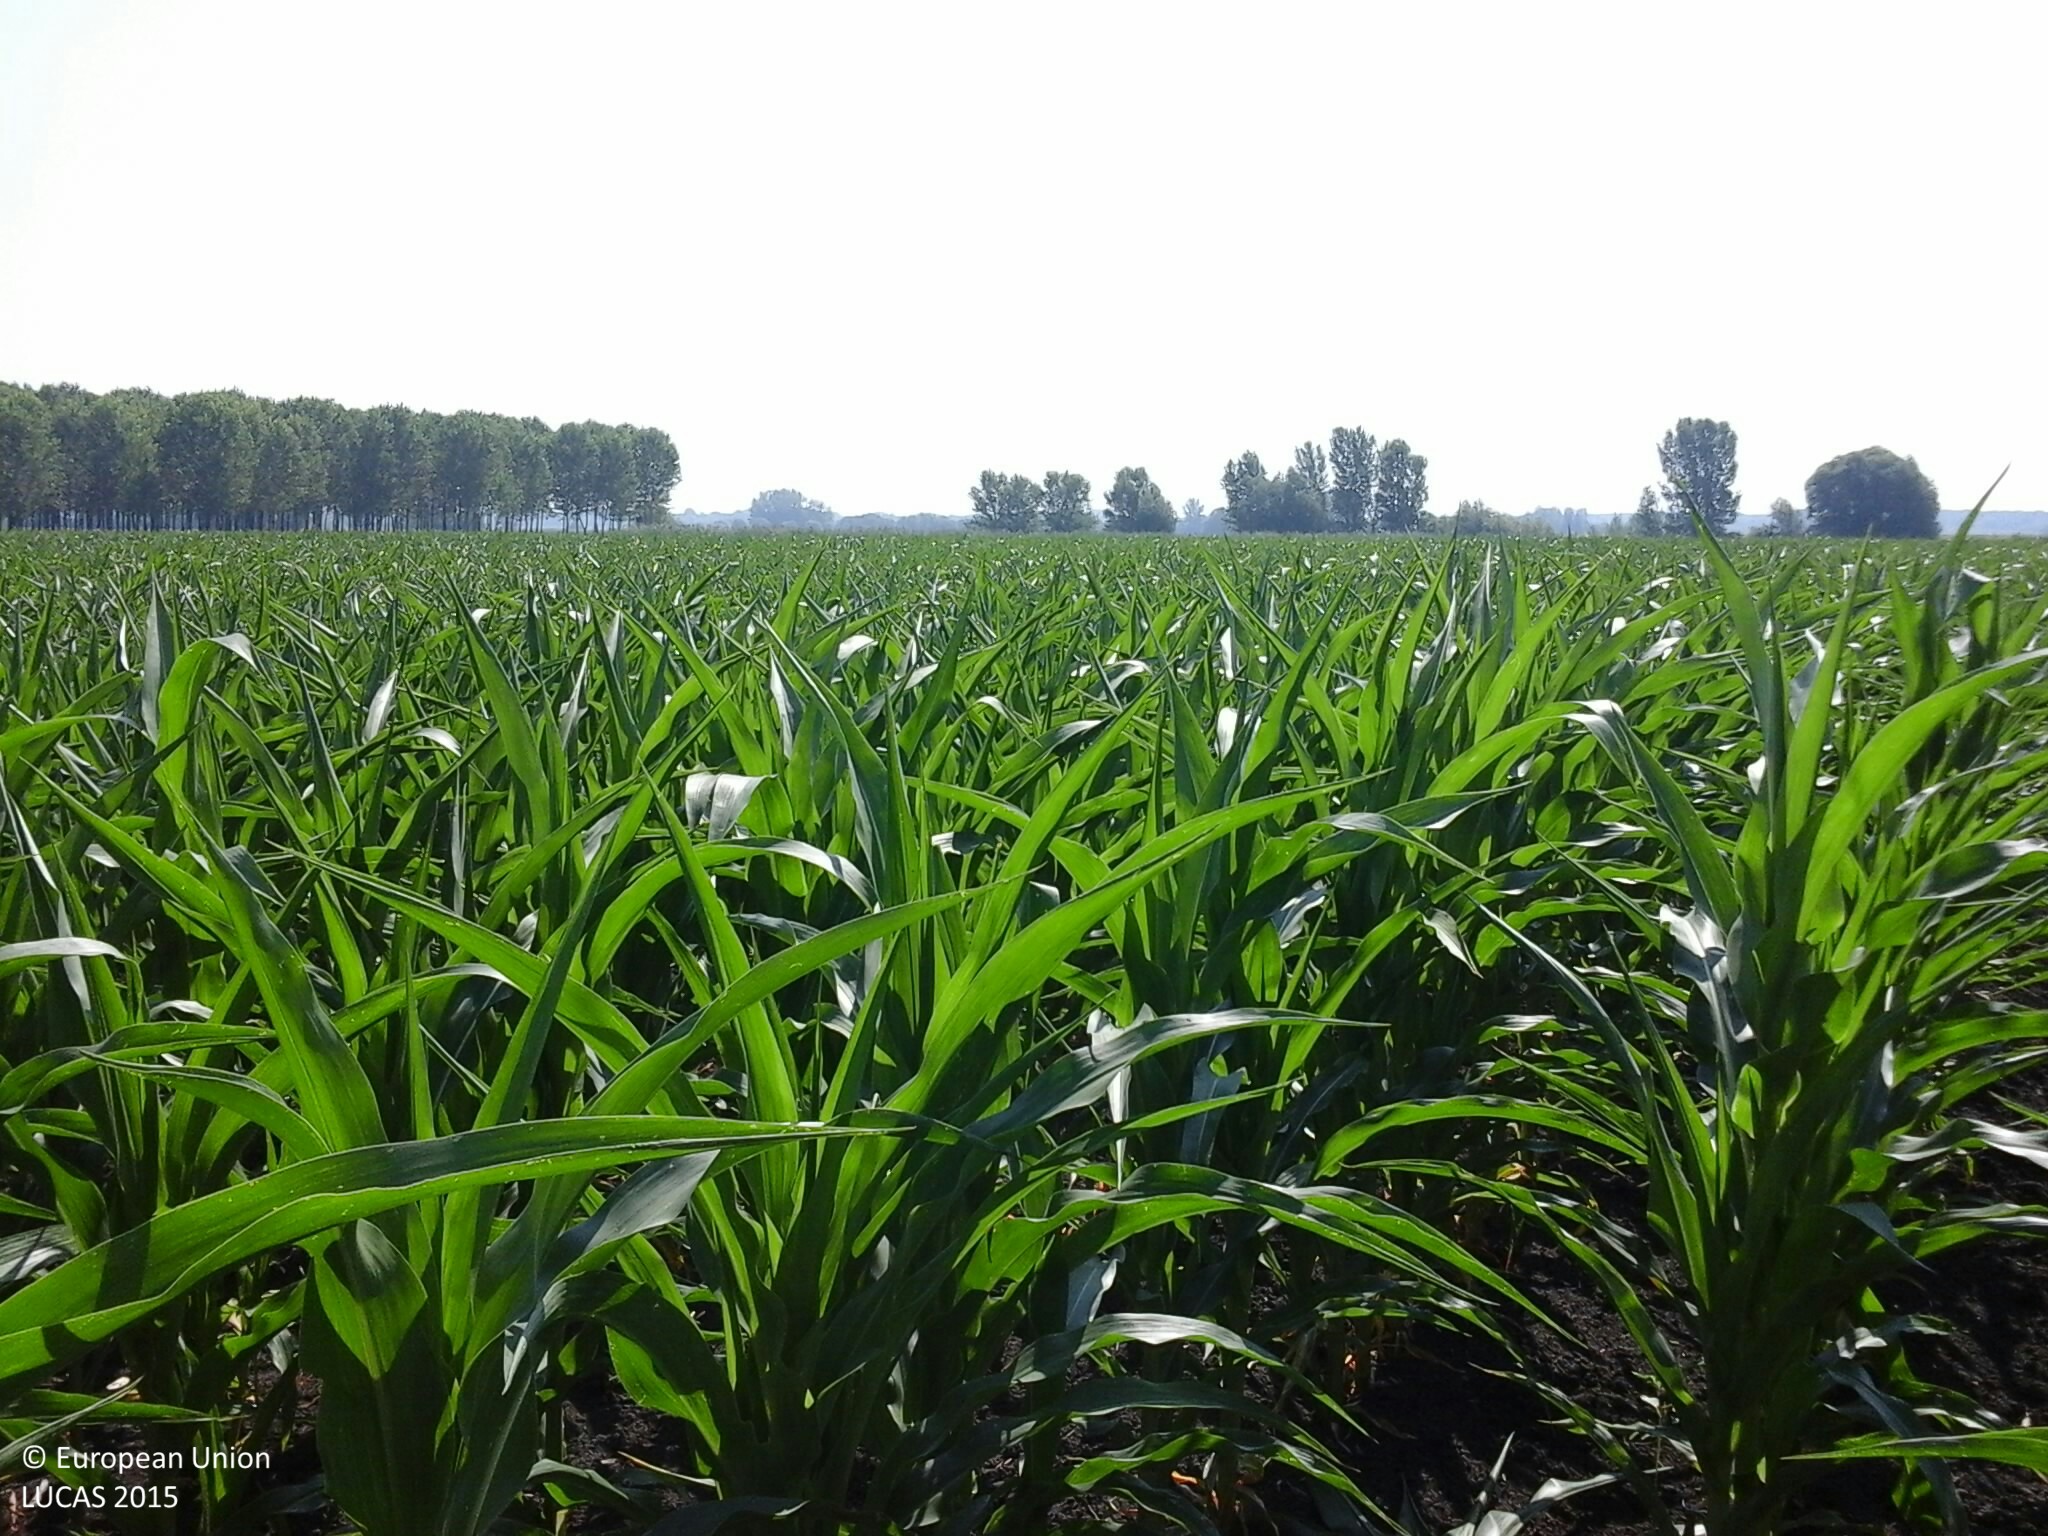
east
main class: Cropland
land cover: Maize
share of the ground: > 75 %
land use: Agriculture (excluding fallow land and kitchen gardens)
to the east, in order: Maize; Grass margins; Ditches and canals; Shruby margins; Soya
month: July
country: HU
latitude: 46.7722
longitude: 20.1737
